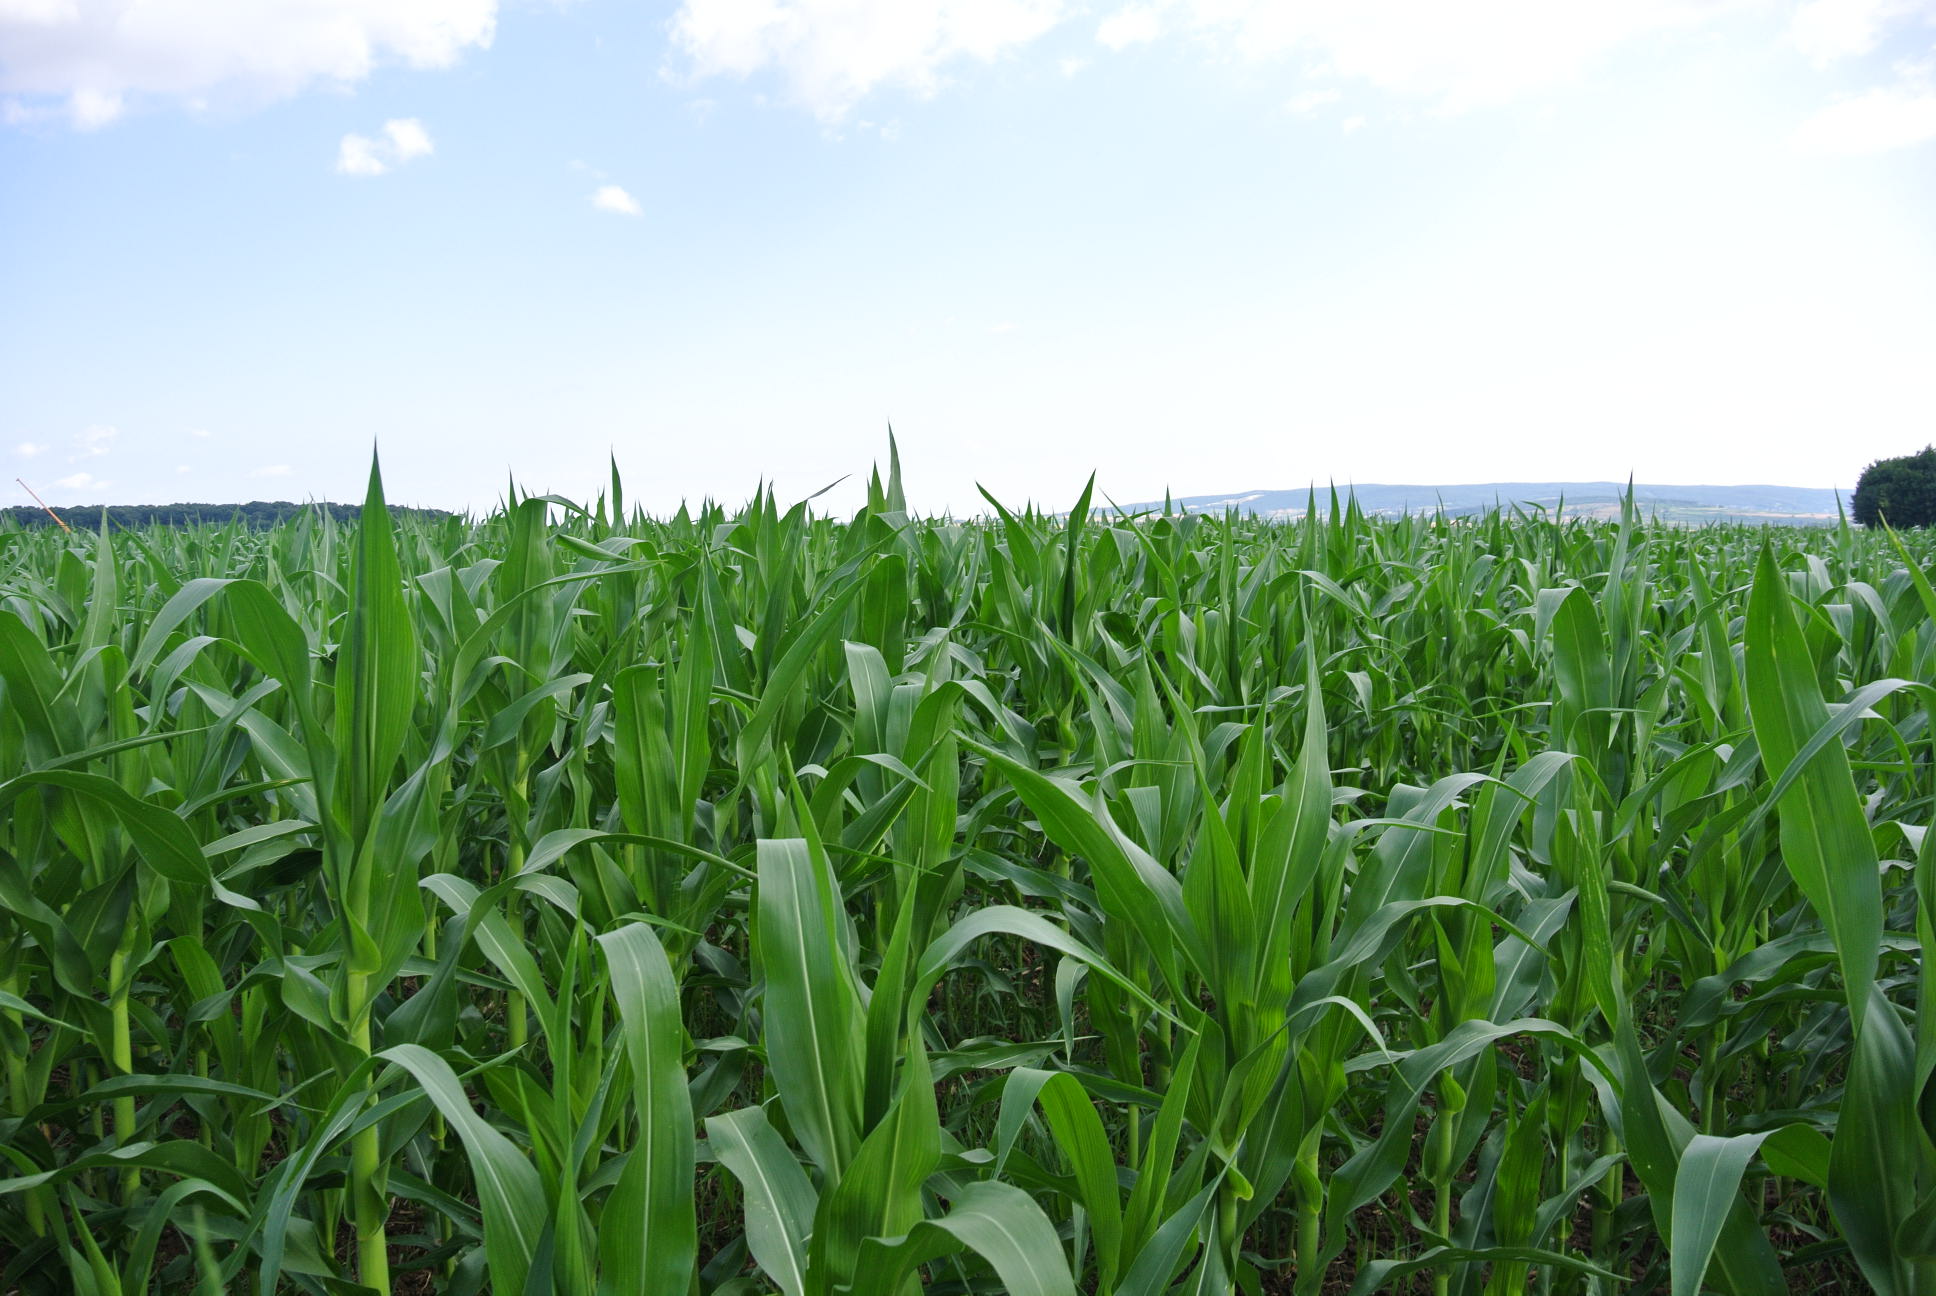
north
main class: Cropland
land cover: Maize
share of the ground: > 75 %
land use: Agriculture (excluding fallow land and kitchen gardens)
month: July
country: AT
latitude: 47.7655
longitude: 16.4219
